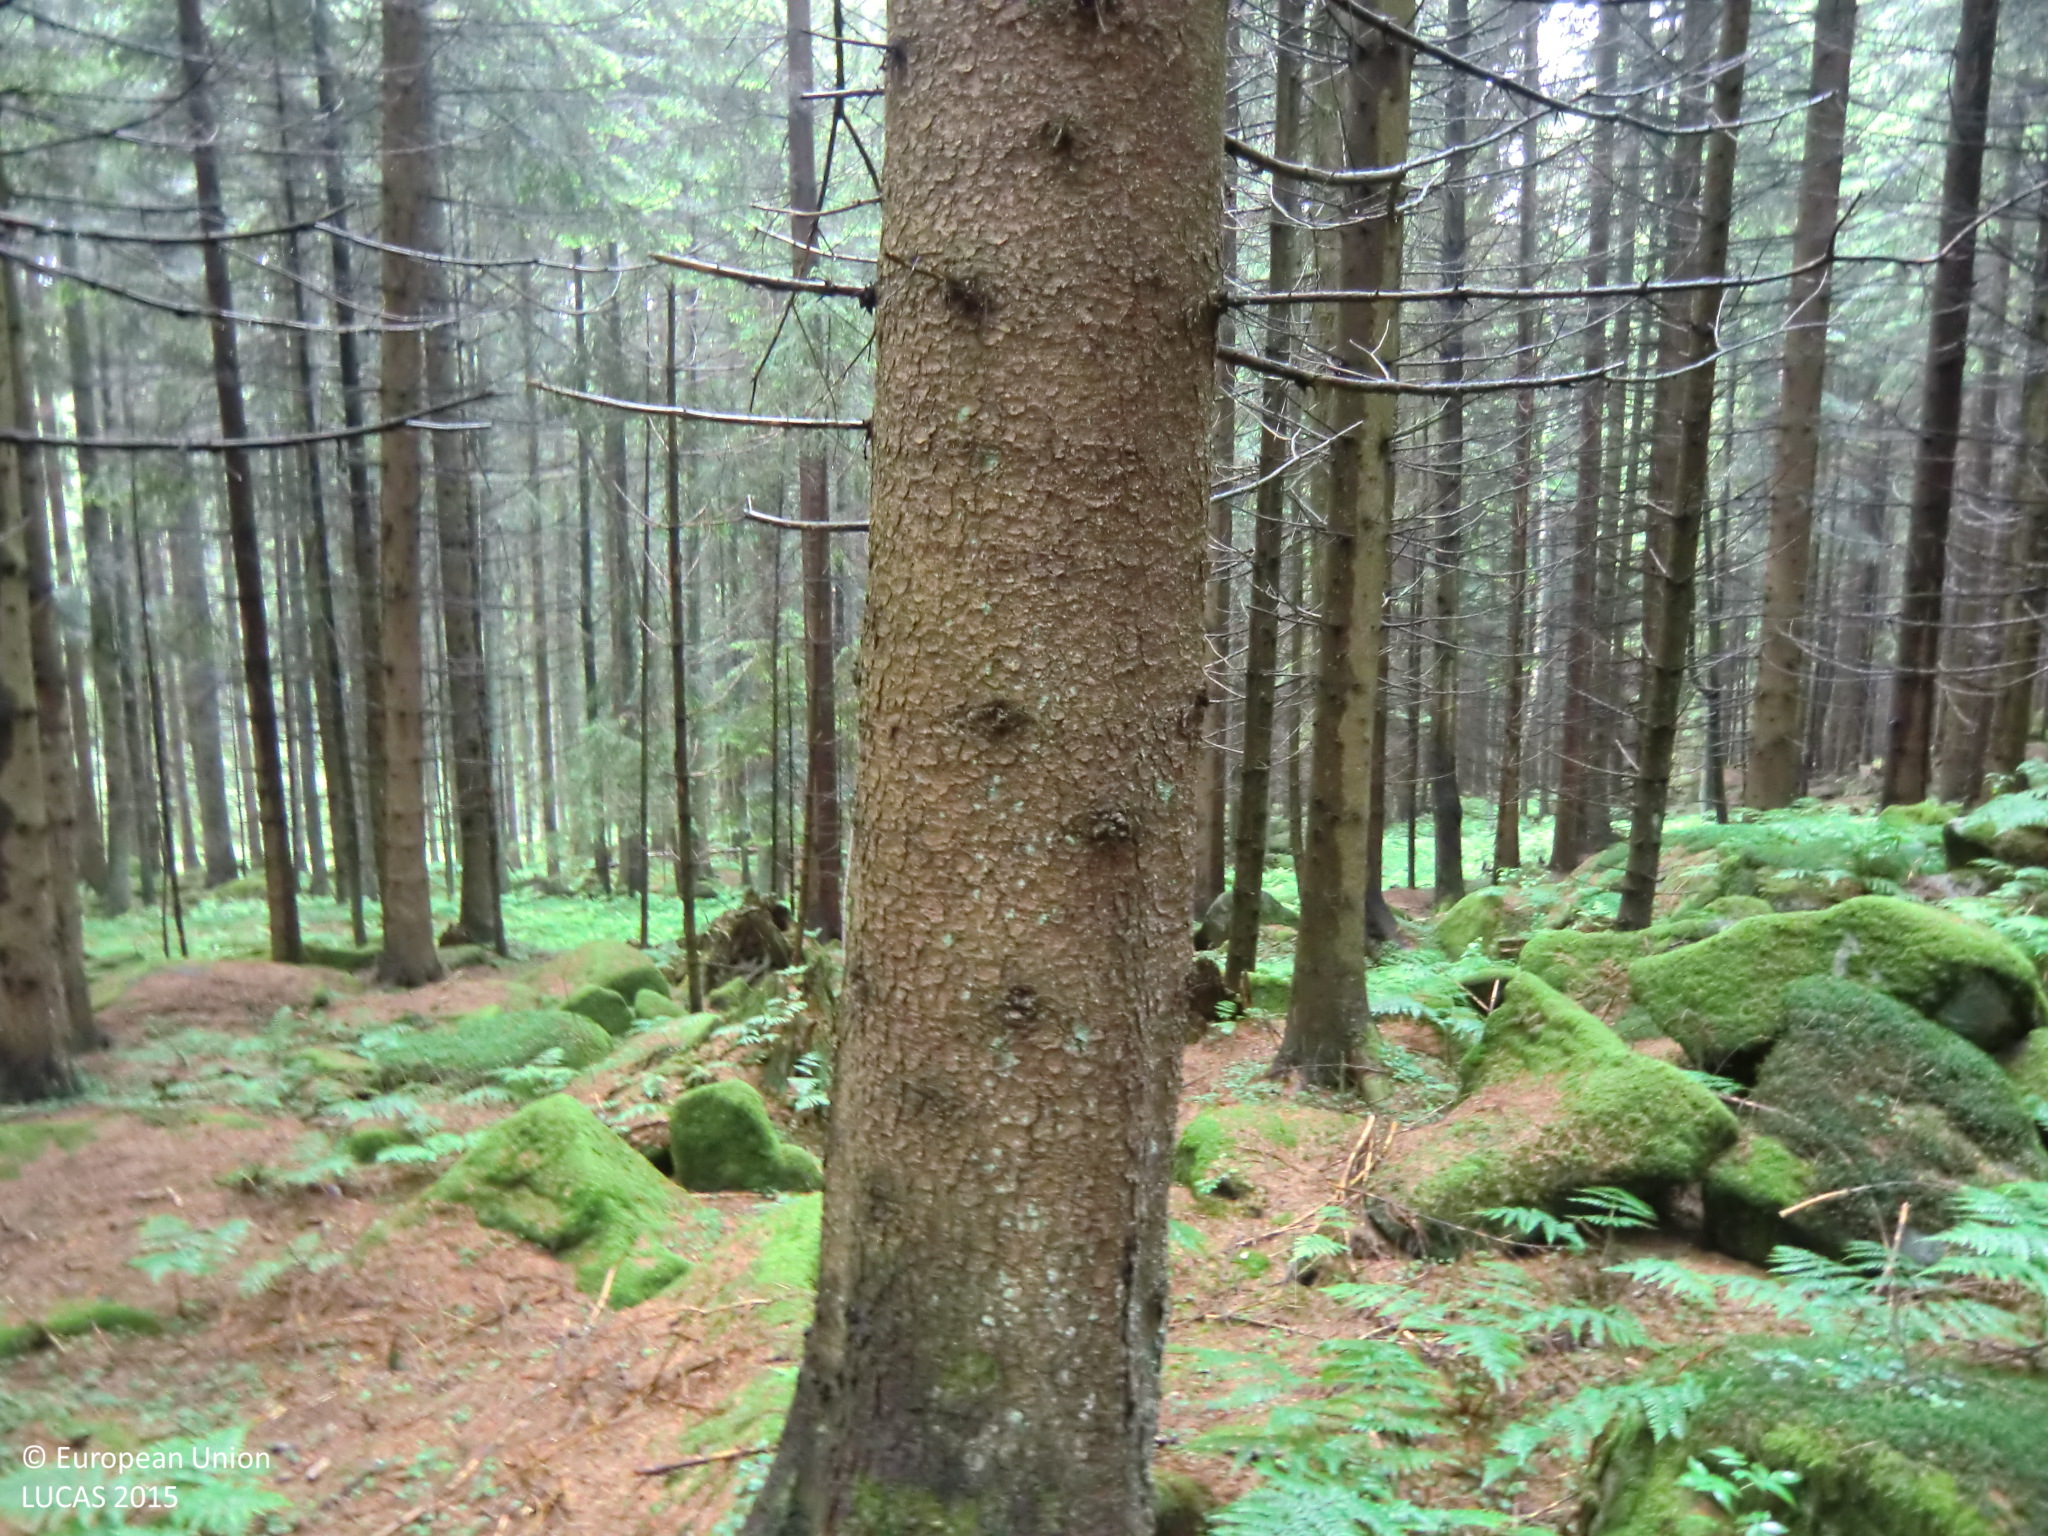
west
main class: Woodland
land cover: Spruce dominated coniferous woodland
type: hemiboreal forest and nemoral coniferous forest and mixed broadleaved-coniferous forest
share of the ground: > 75 %
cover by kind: coniferous forest trees 75 %, unconsolidated bare surface 15 %, herbaceous plants 10 %
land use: Forestry
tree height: > 5 m
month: June
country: AT
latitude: 48.5244
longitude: 14.5910
